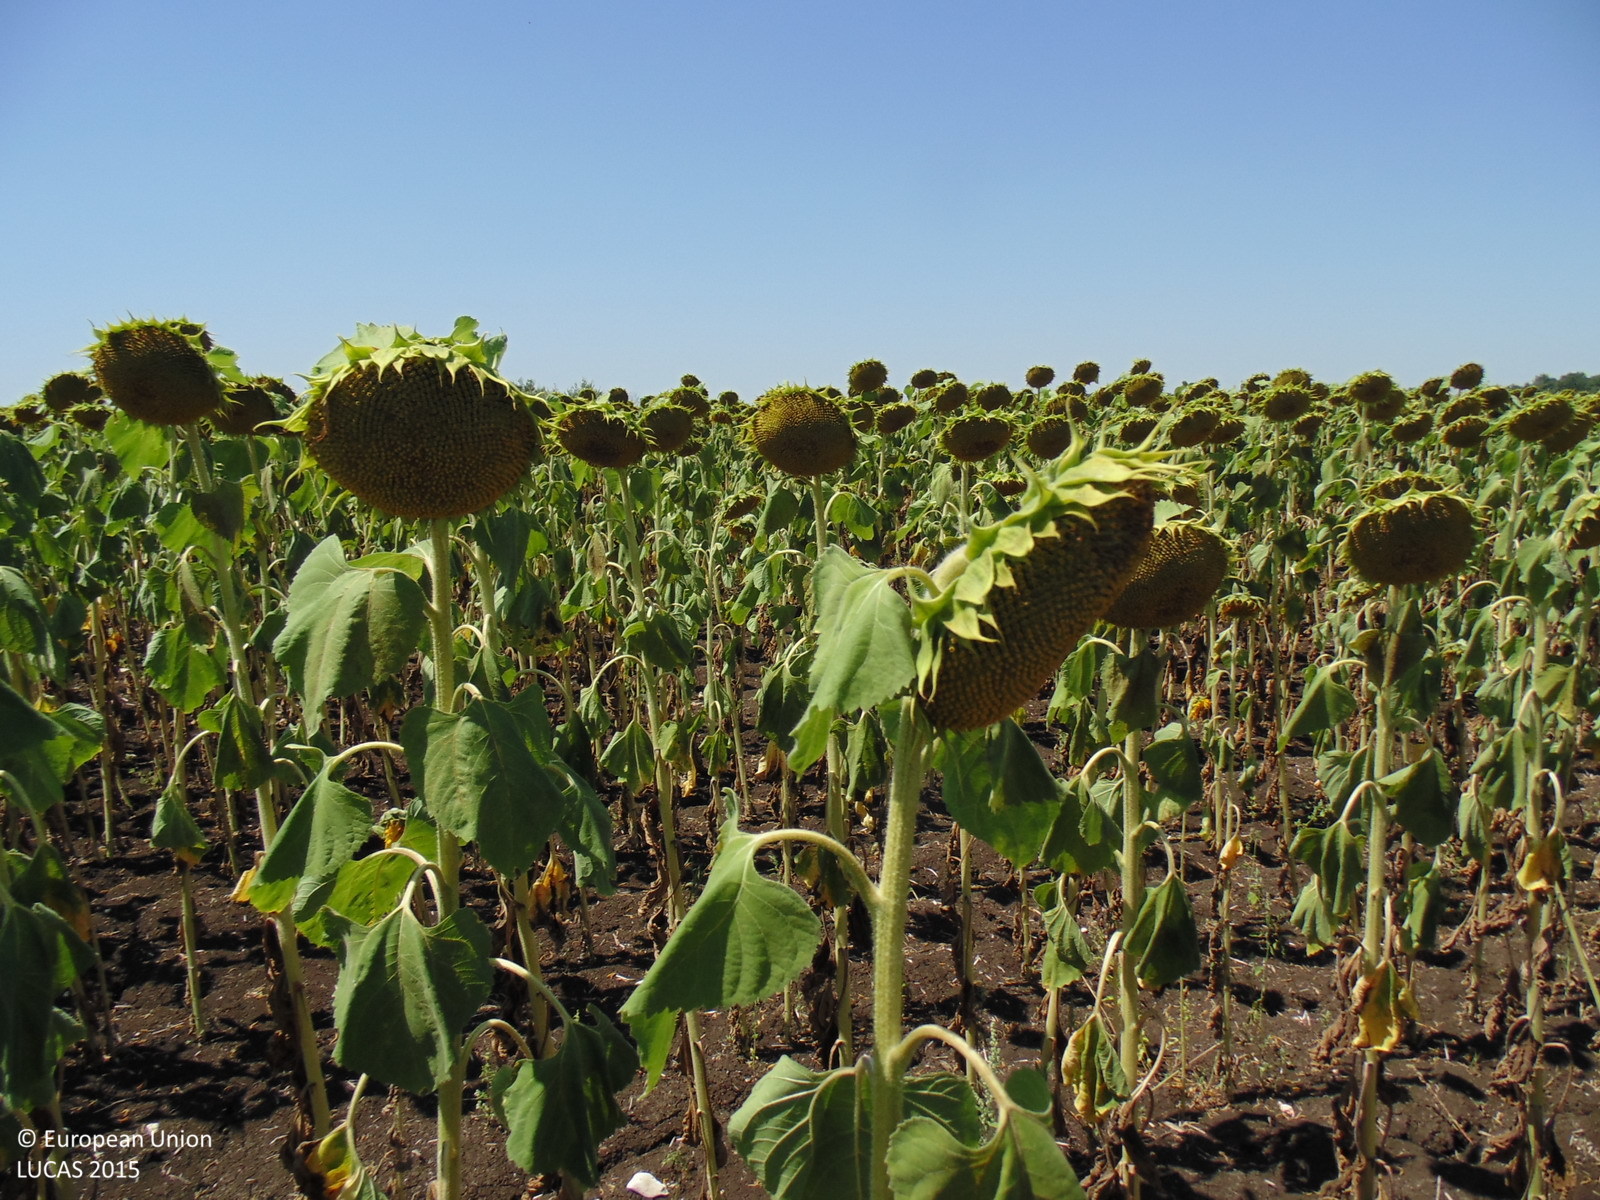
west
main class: Cropland
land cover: Sunflower
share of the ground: > 75 %
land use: Agriculture (excluding fallow land and kitchen gardens)
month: August
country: BG
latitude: 43.5045
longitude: 28.1716
